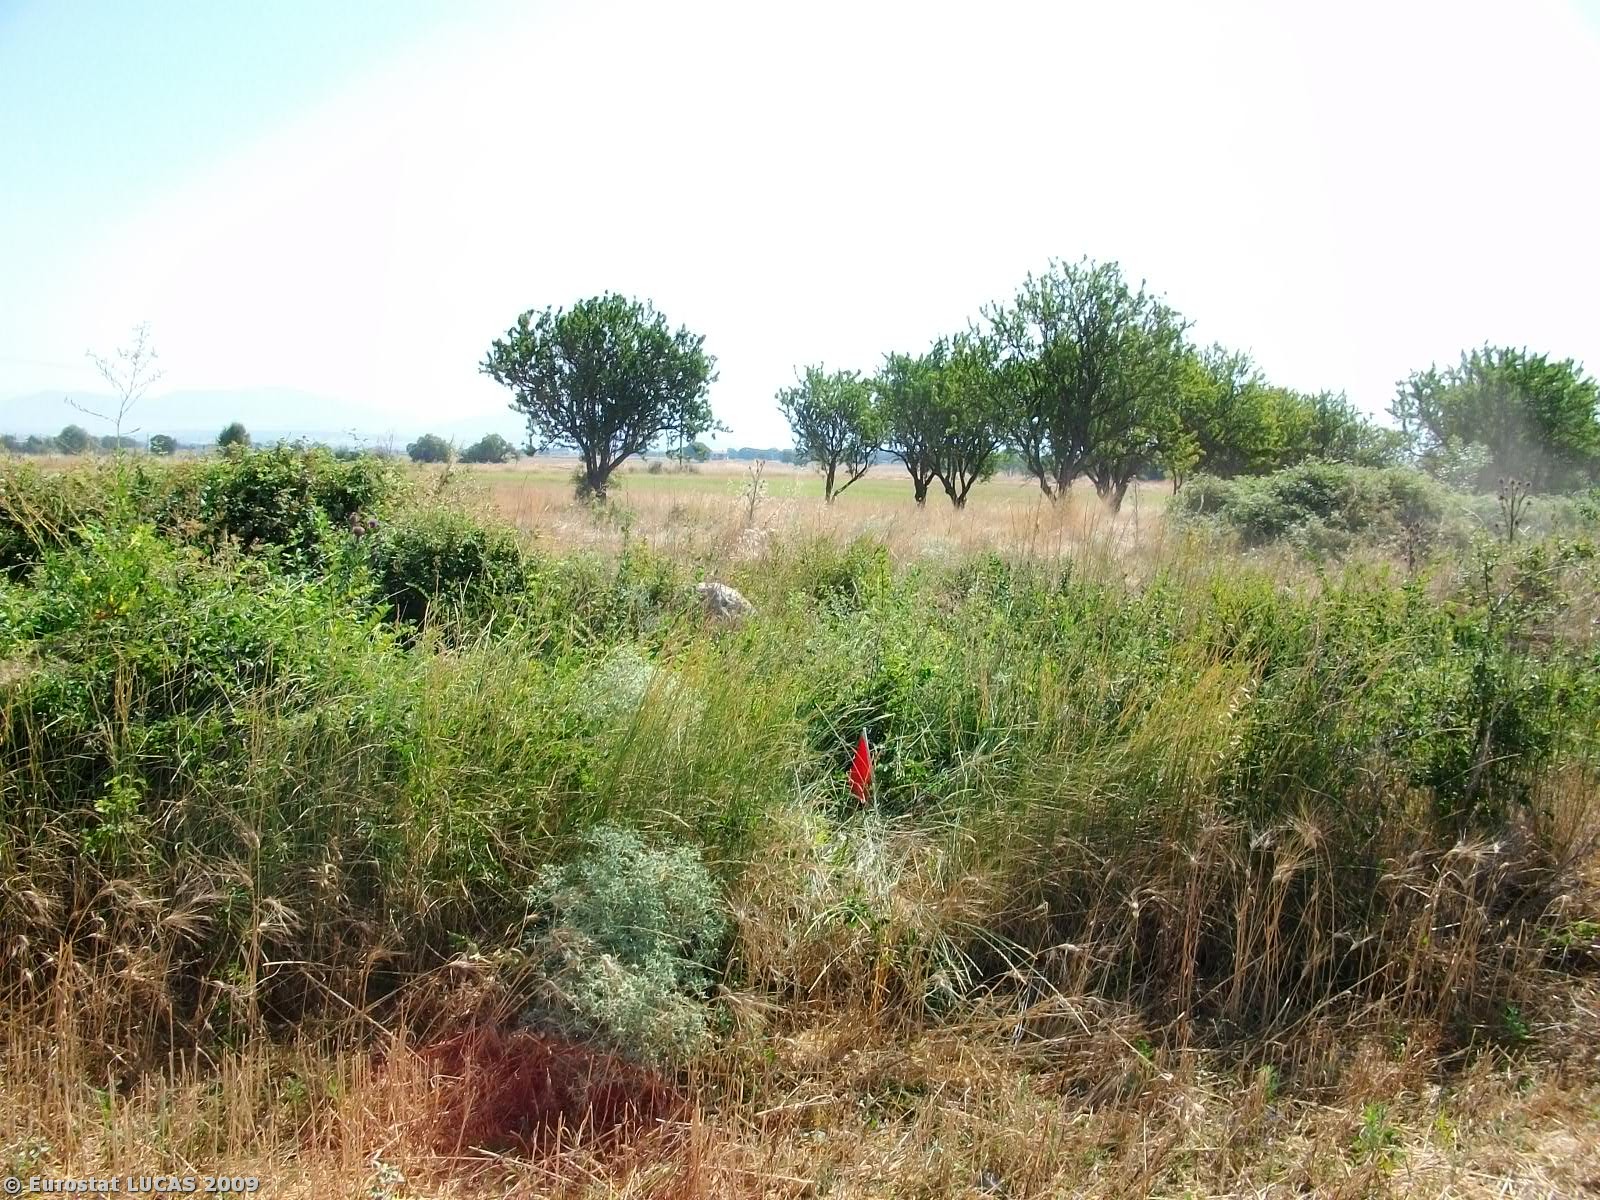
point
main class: Shrubland
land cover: Shrubland with sparse tree cover
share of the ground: > 75 %
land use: Unused
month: July
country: GR
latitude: 40.2666
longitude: 21.7858
